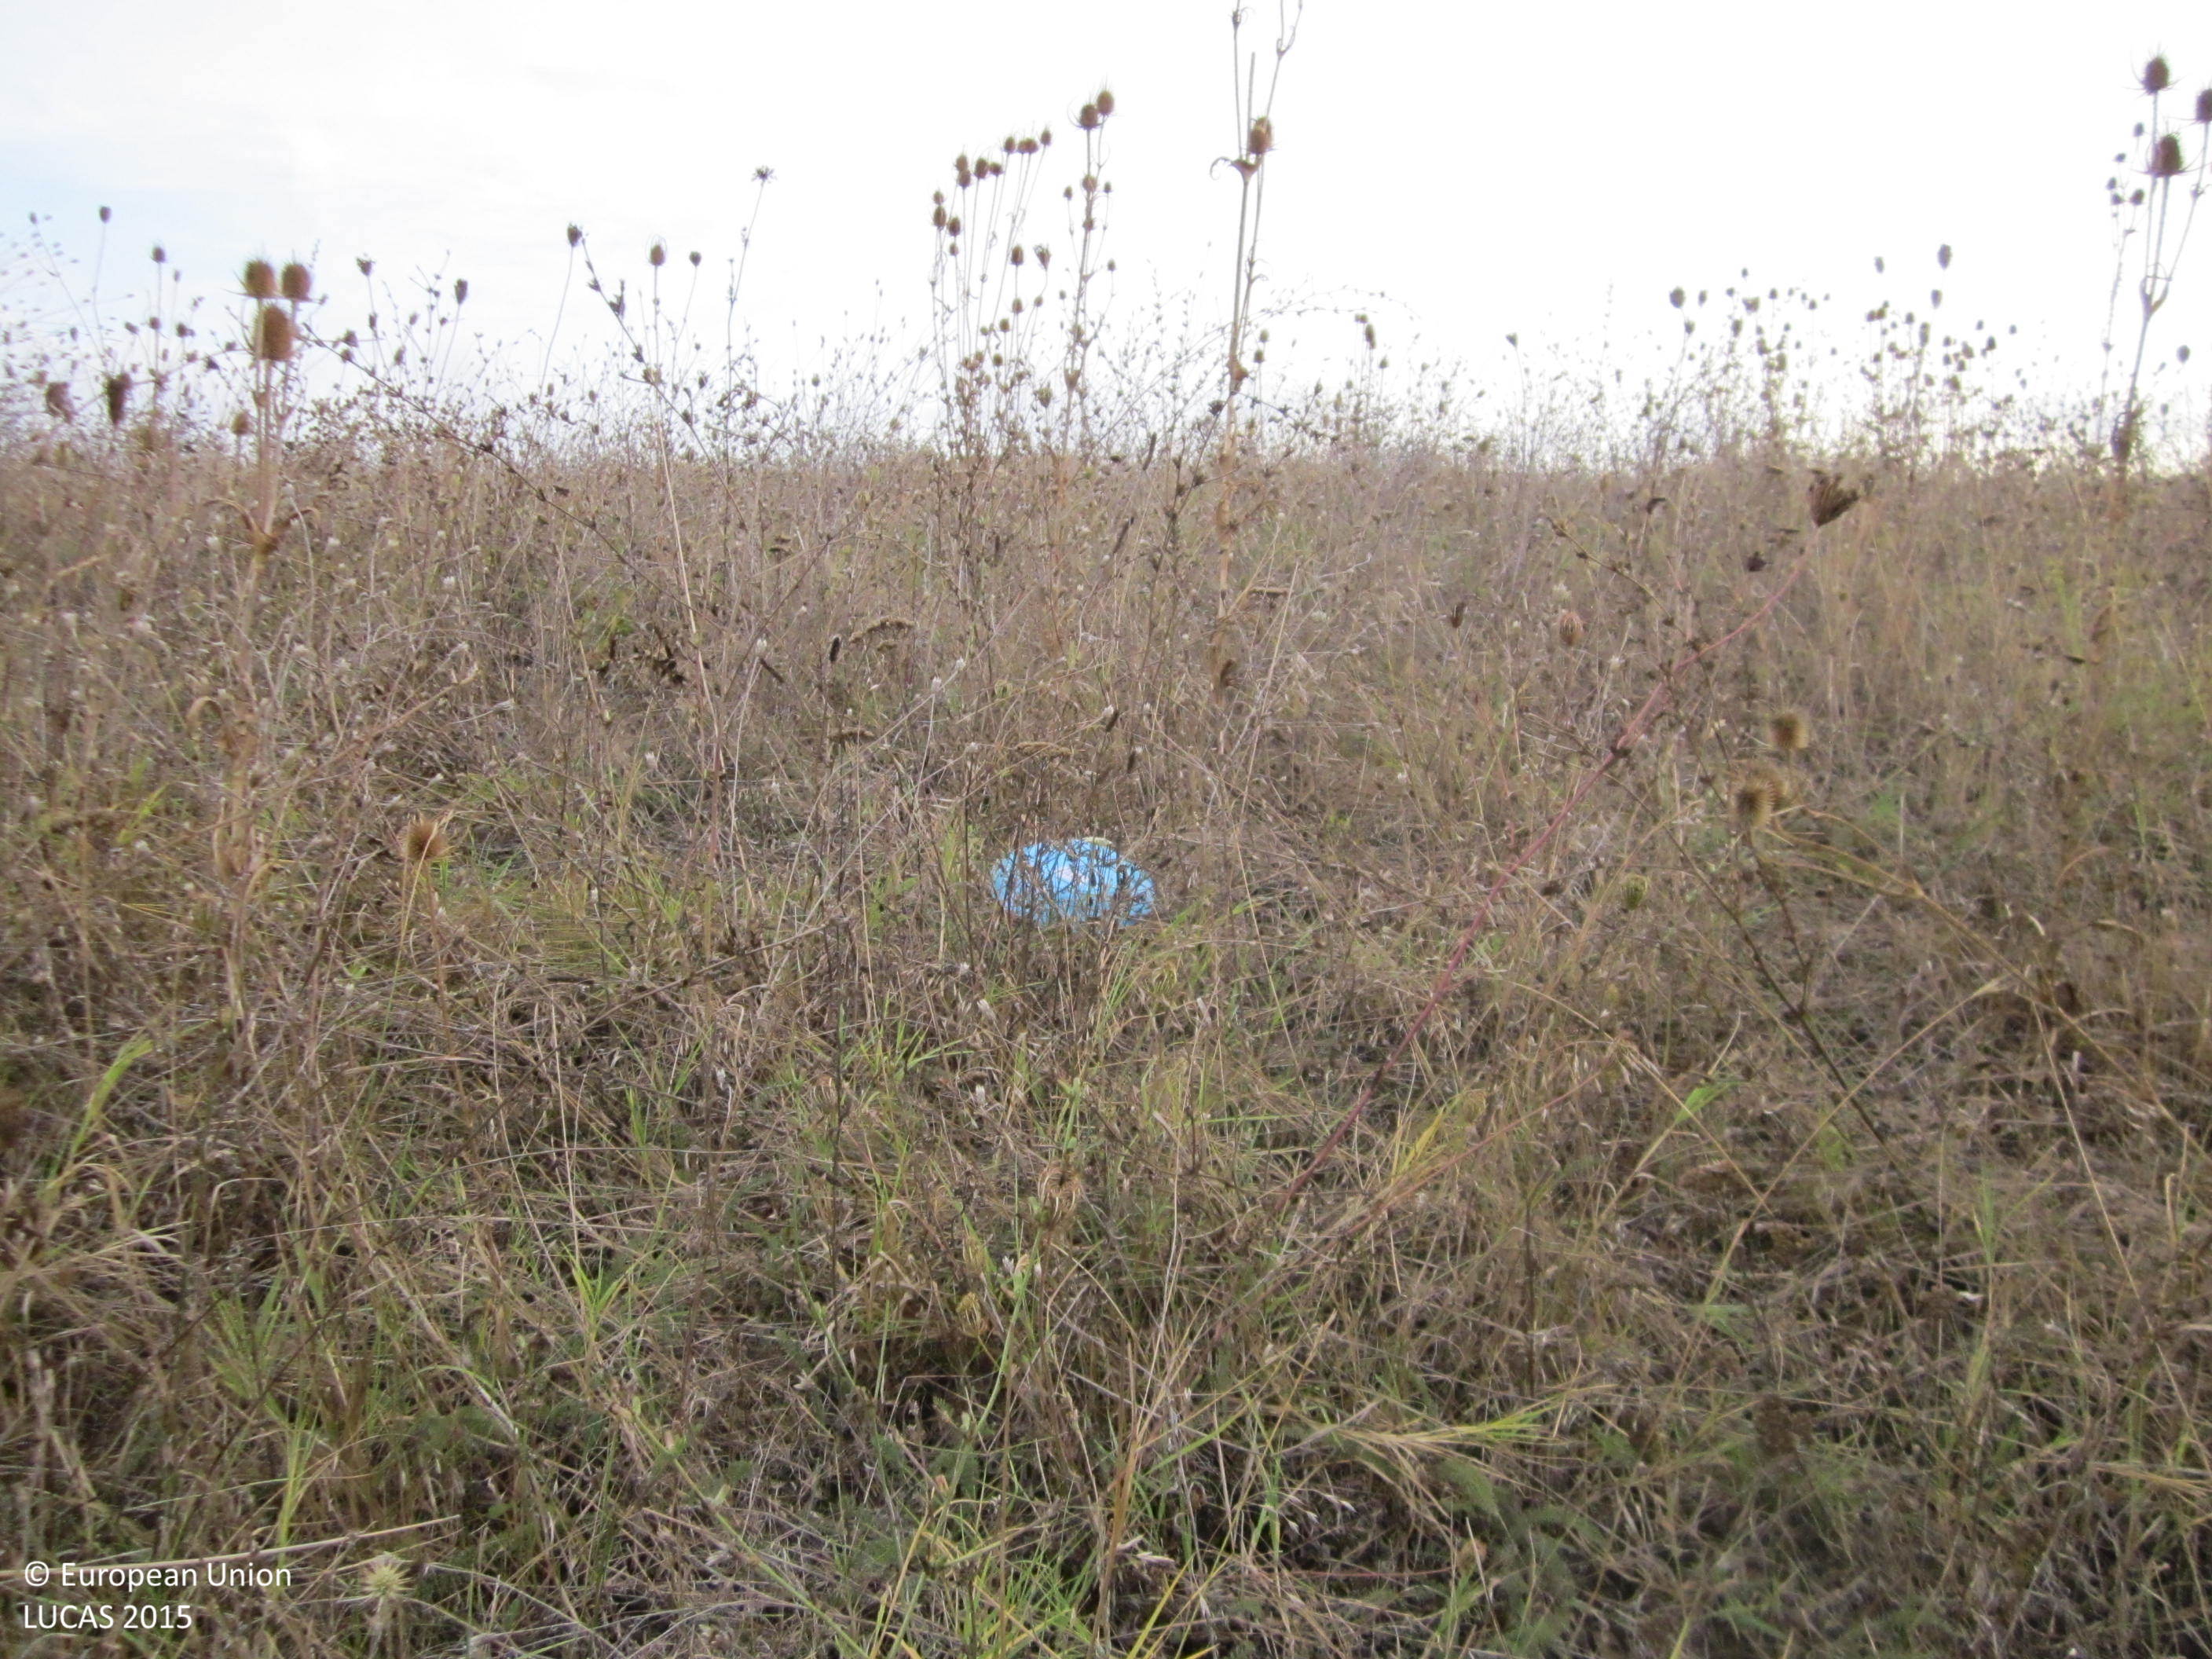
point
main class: Grassland
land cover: Grassland without tree/shrub cover
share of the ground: > 75 %
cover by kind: herbaceous plants 100 %
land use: Agriculture (excluding fallow land and kitchen gardens)
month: September
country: BG
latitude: 42.3899
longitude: 27.1745
